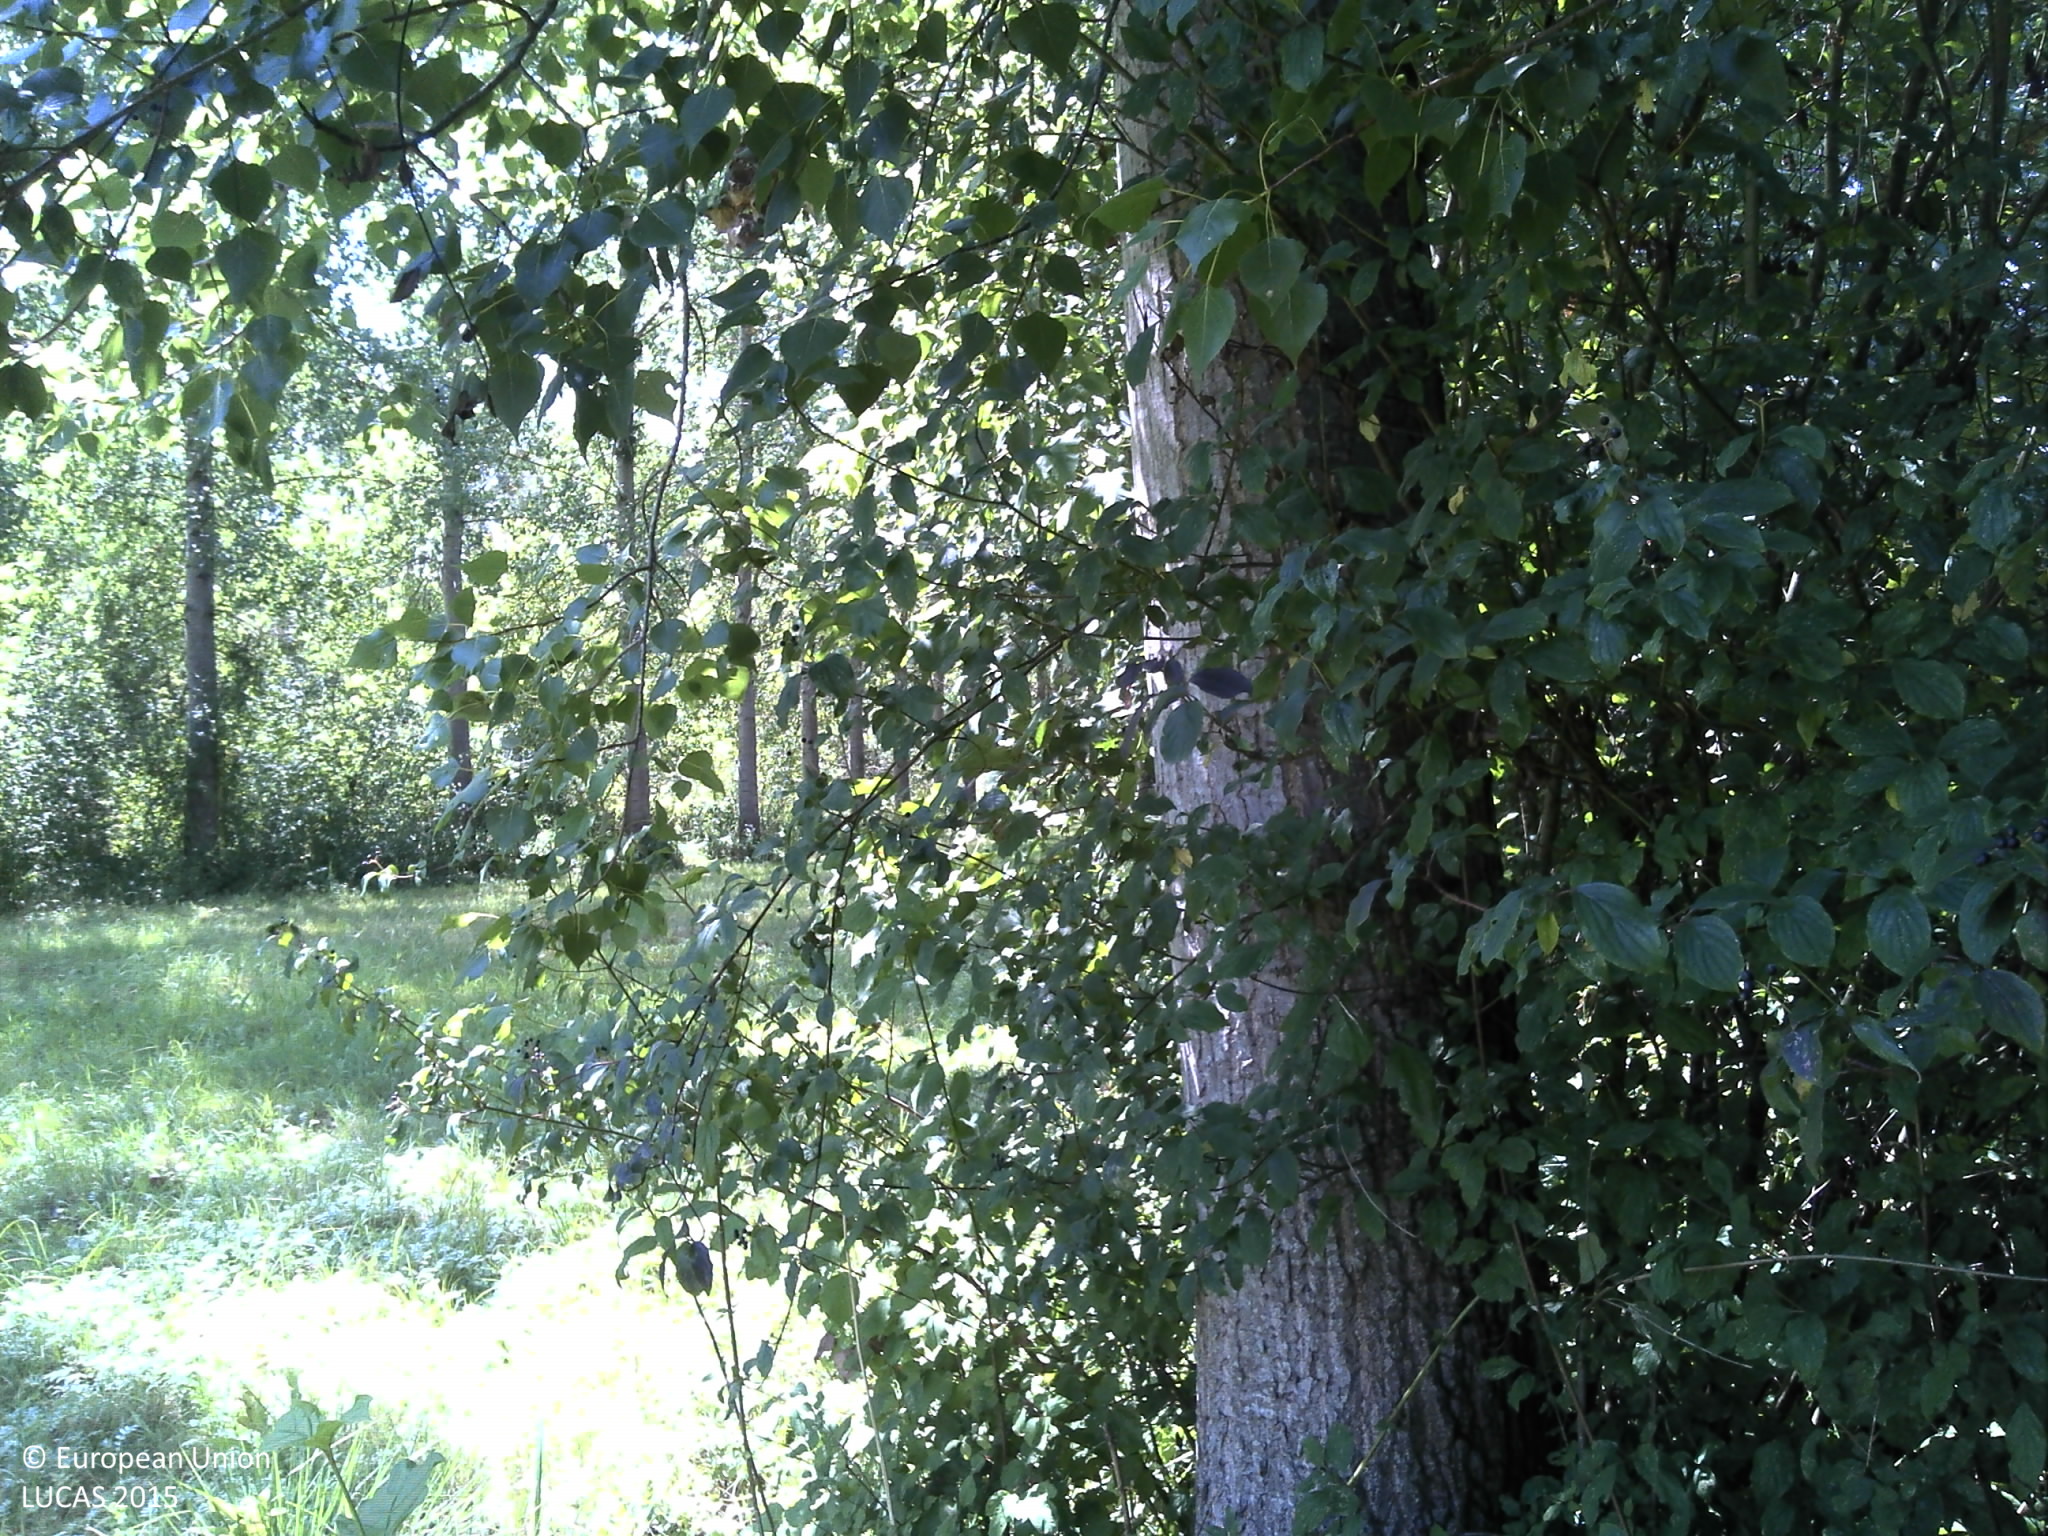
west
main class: Woodland
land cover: Broadleaved woodland
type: exotic forest
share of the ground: > 75 %
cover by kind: broadleaved forest trees 70 %, herbaceous plants 30 %
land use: Forestry
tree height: > 5 m
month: August
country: FR
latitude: 48.4806
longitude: 3.4596
